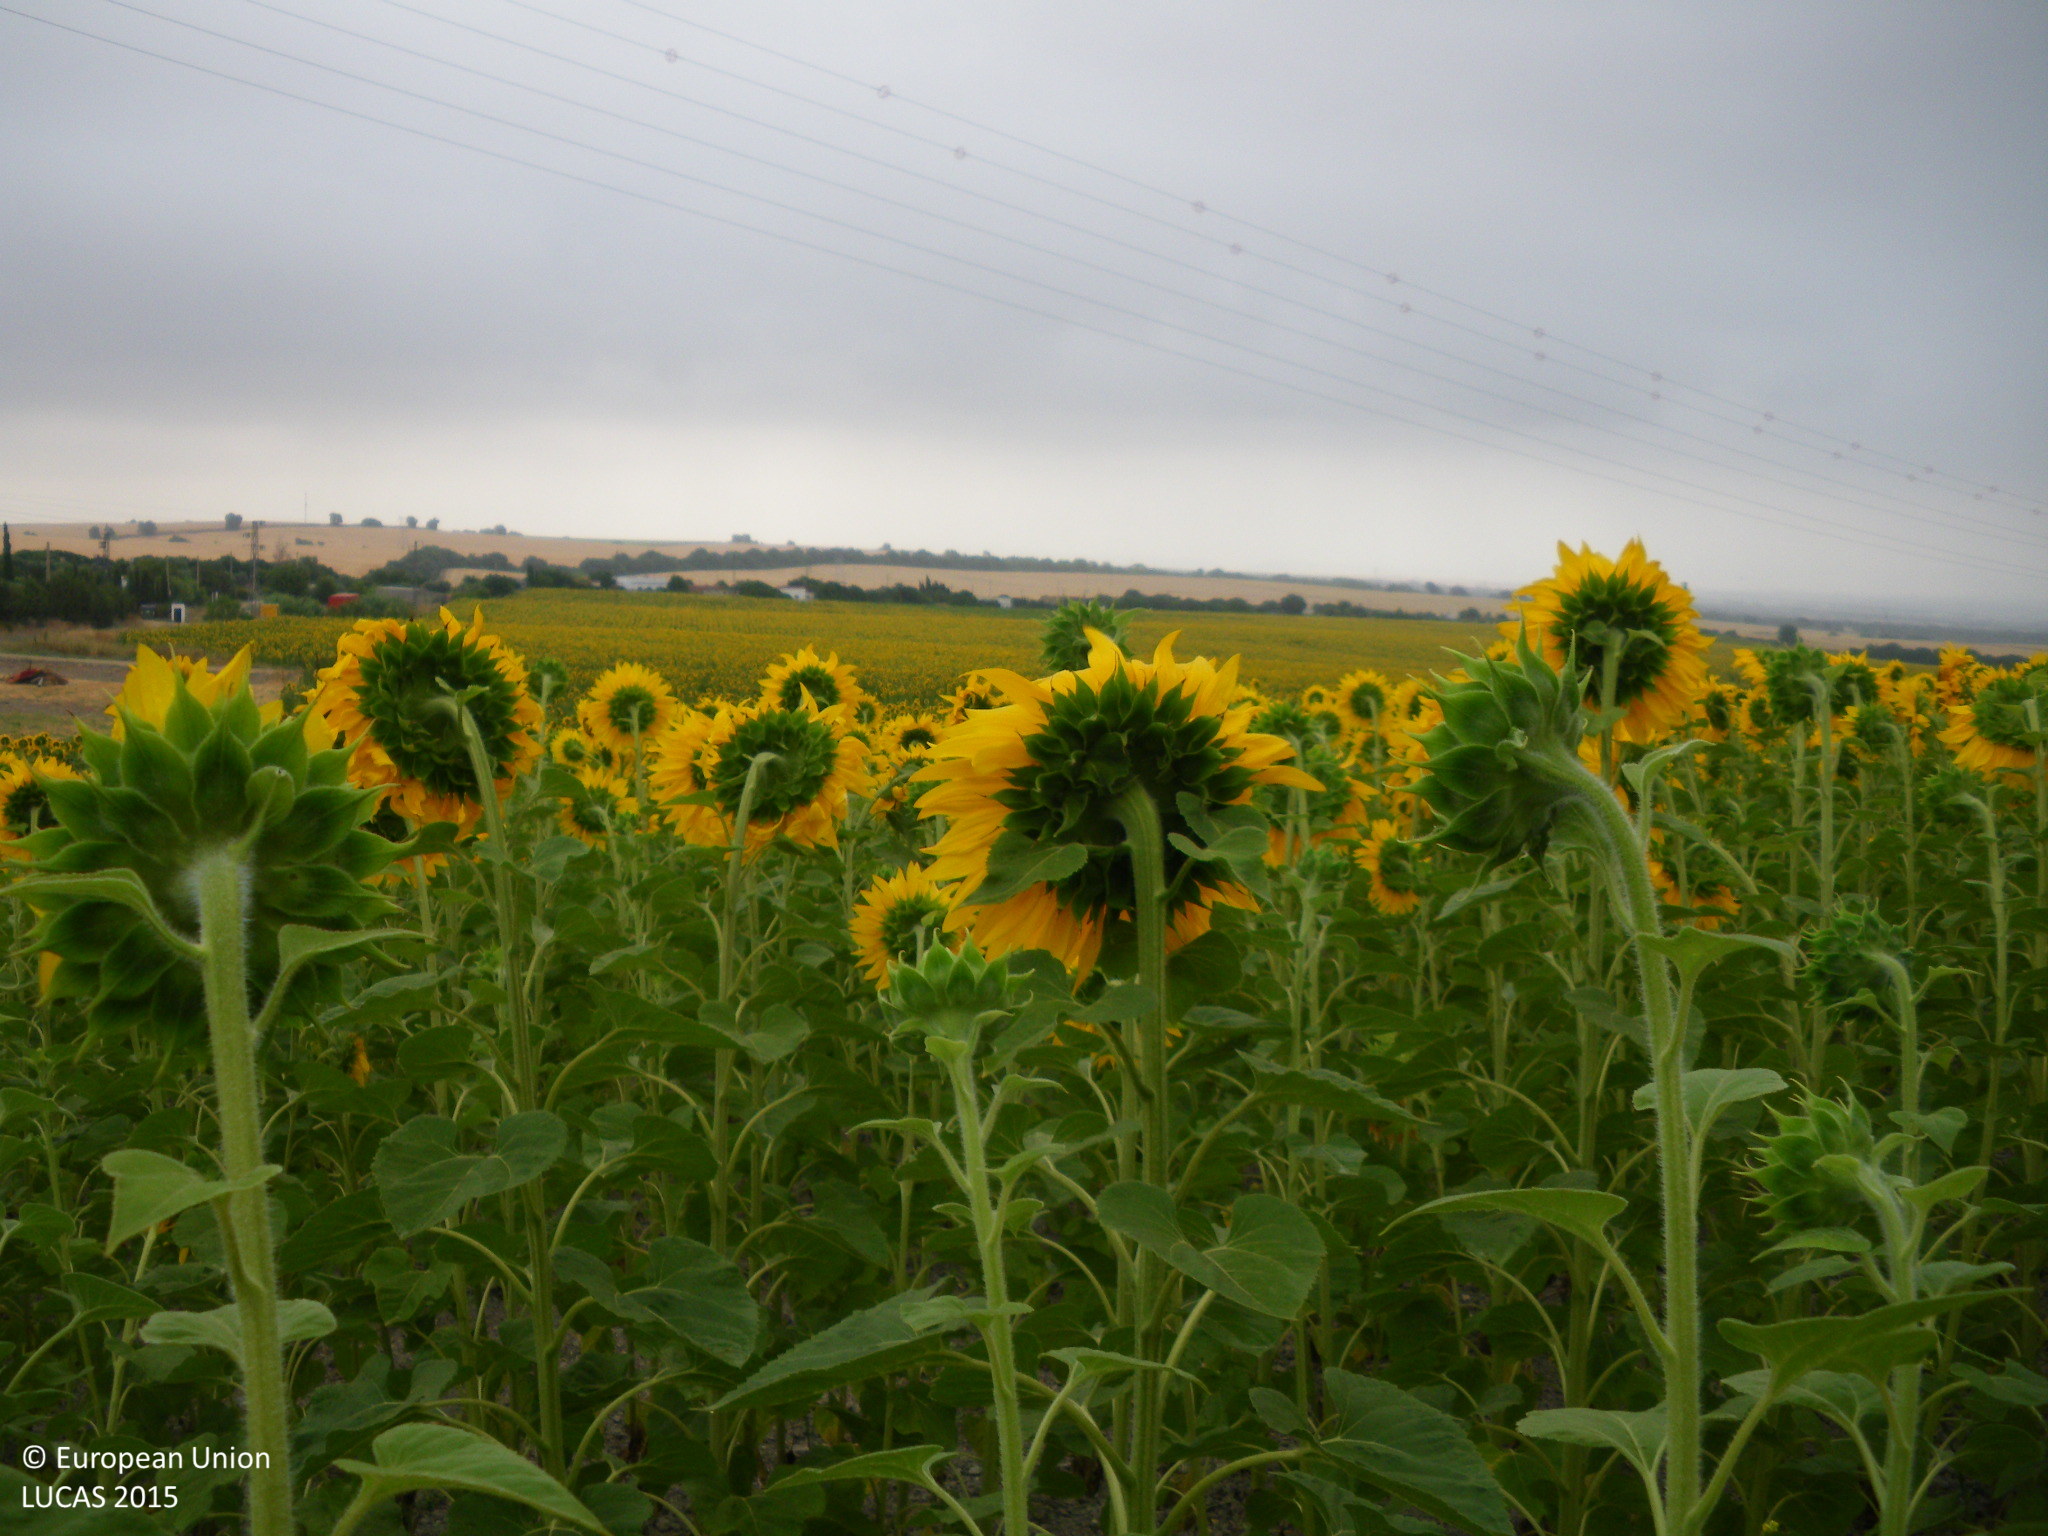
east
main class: Cropland
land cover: Sunflower
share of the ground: > 75 %
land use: Agriculture (excluding fallow land and kitchen gardens)
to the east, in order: Sunflower; Electric lines; Sunflower; Lines of trees; Ditches and canals; Tracks; Grassland without tree/shrub cover; Sunflower; Electric lines; Sunflower
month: June
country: ES
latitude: 36.6783
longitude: -6.0005
